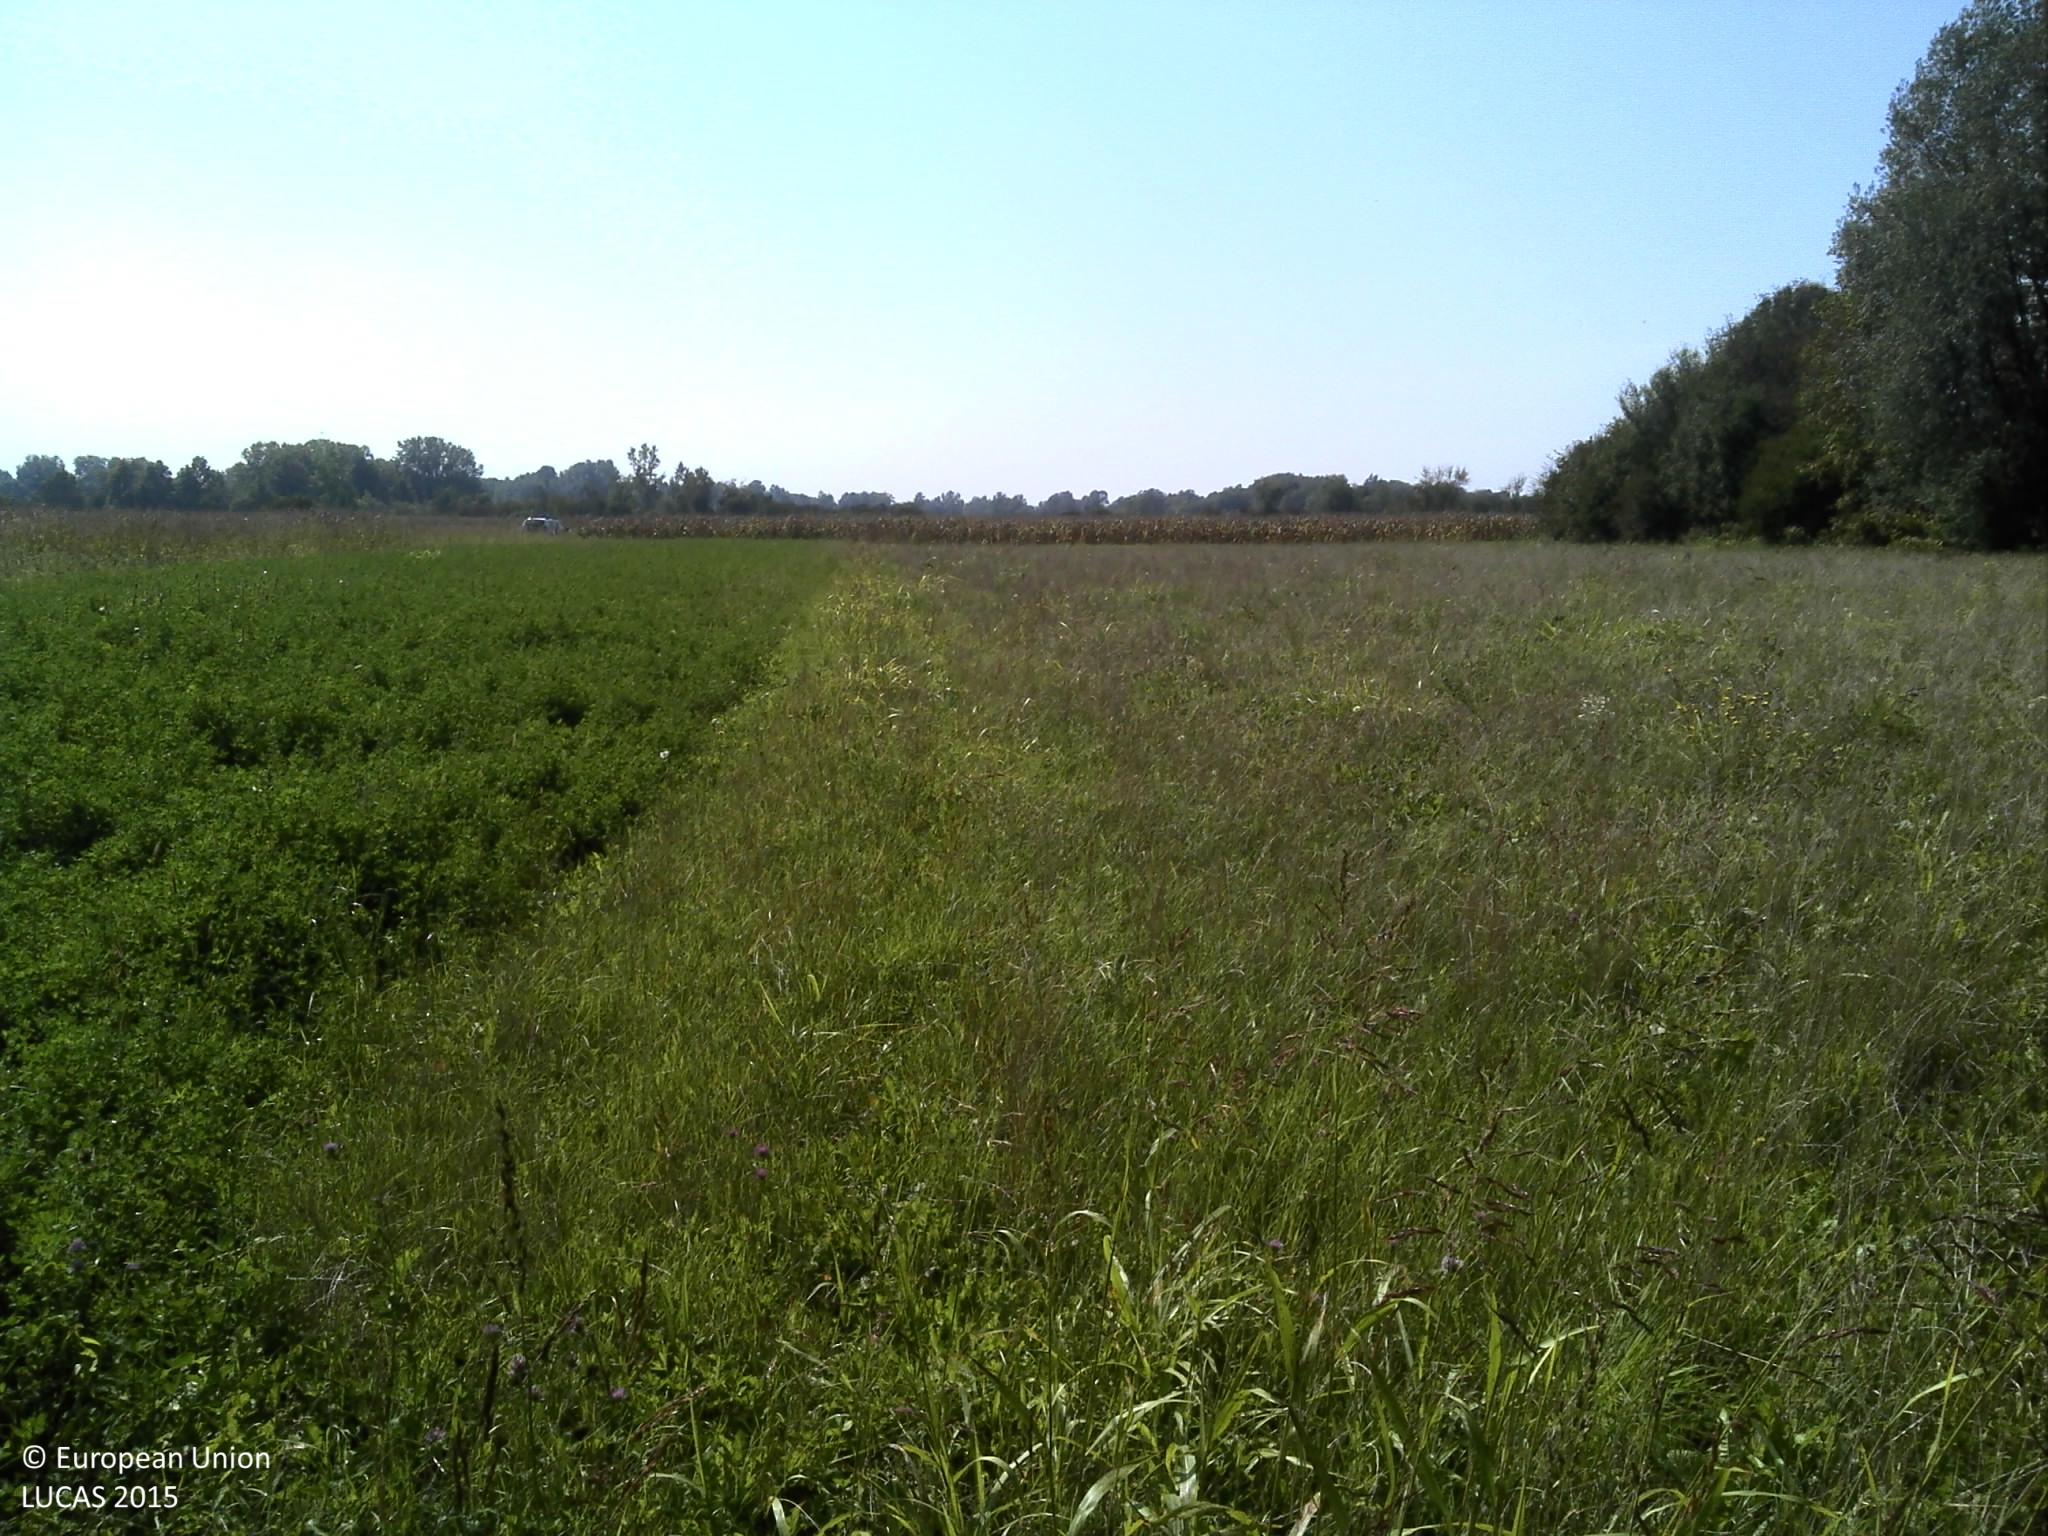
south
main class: Grassland
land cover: Grassland without tree/shrub cover
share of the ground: > 75 %
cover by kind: herbaceous plants 100 %
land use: Semi-natural and natural areas not in use
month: September
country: HR
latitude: 45.6401
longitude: 16.3231
